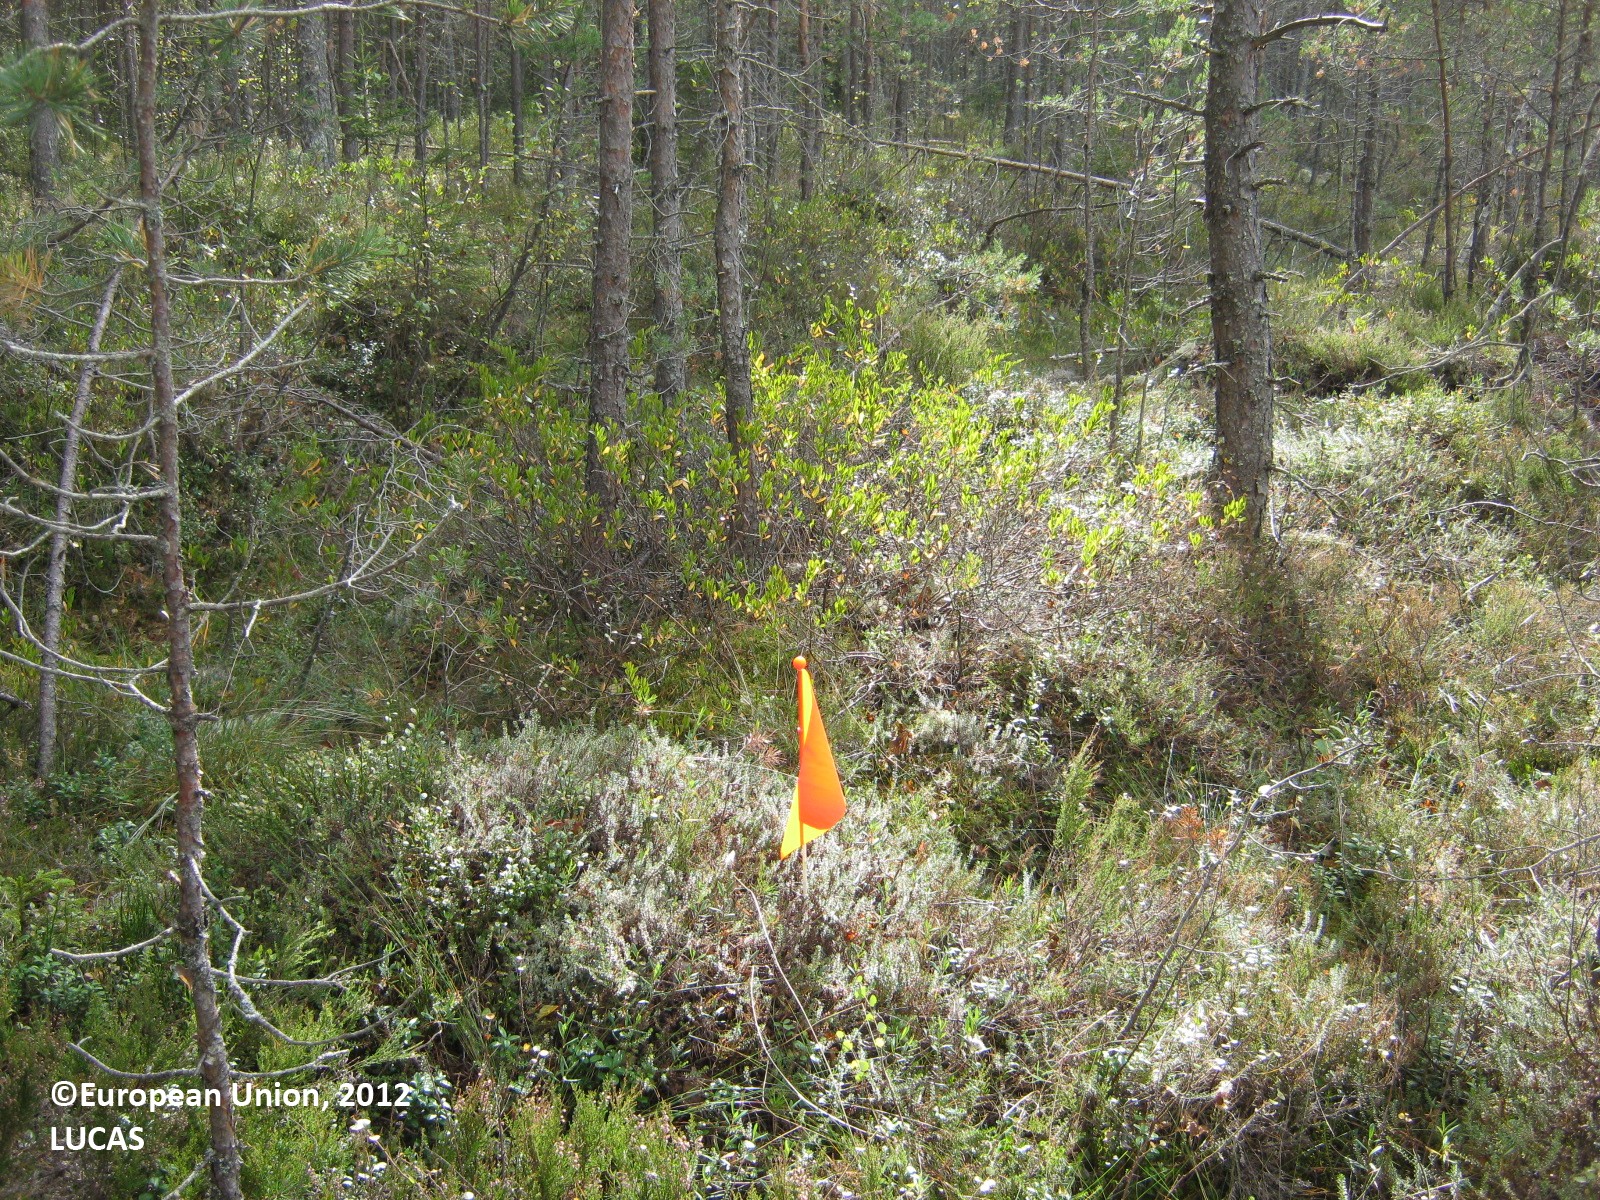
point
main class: Woodland
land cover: Pine dominated coniferous woodland
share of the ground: 50 - 75 %
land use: Forestry
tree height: < 5 m
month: September
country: FI
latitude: 60.9818
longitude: 28.2253
